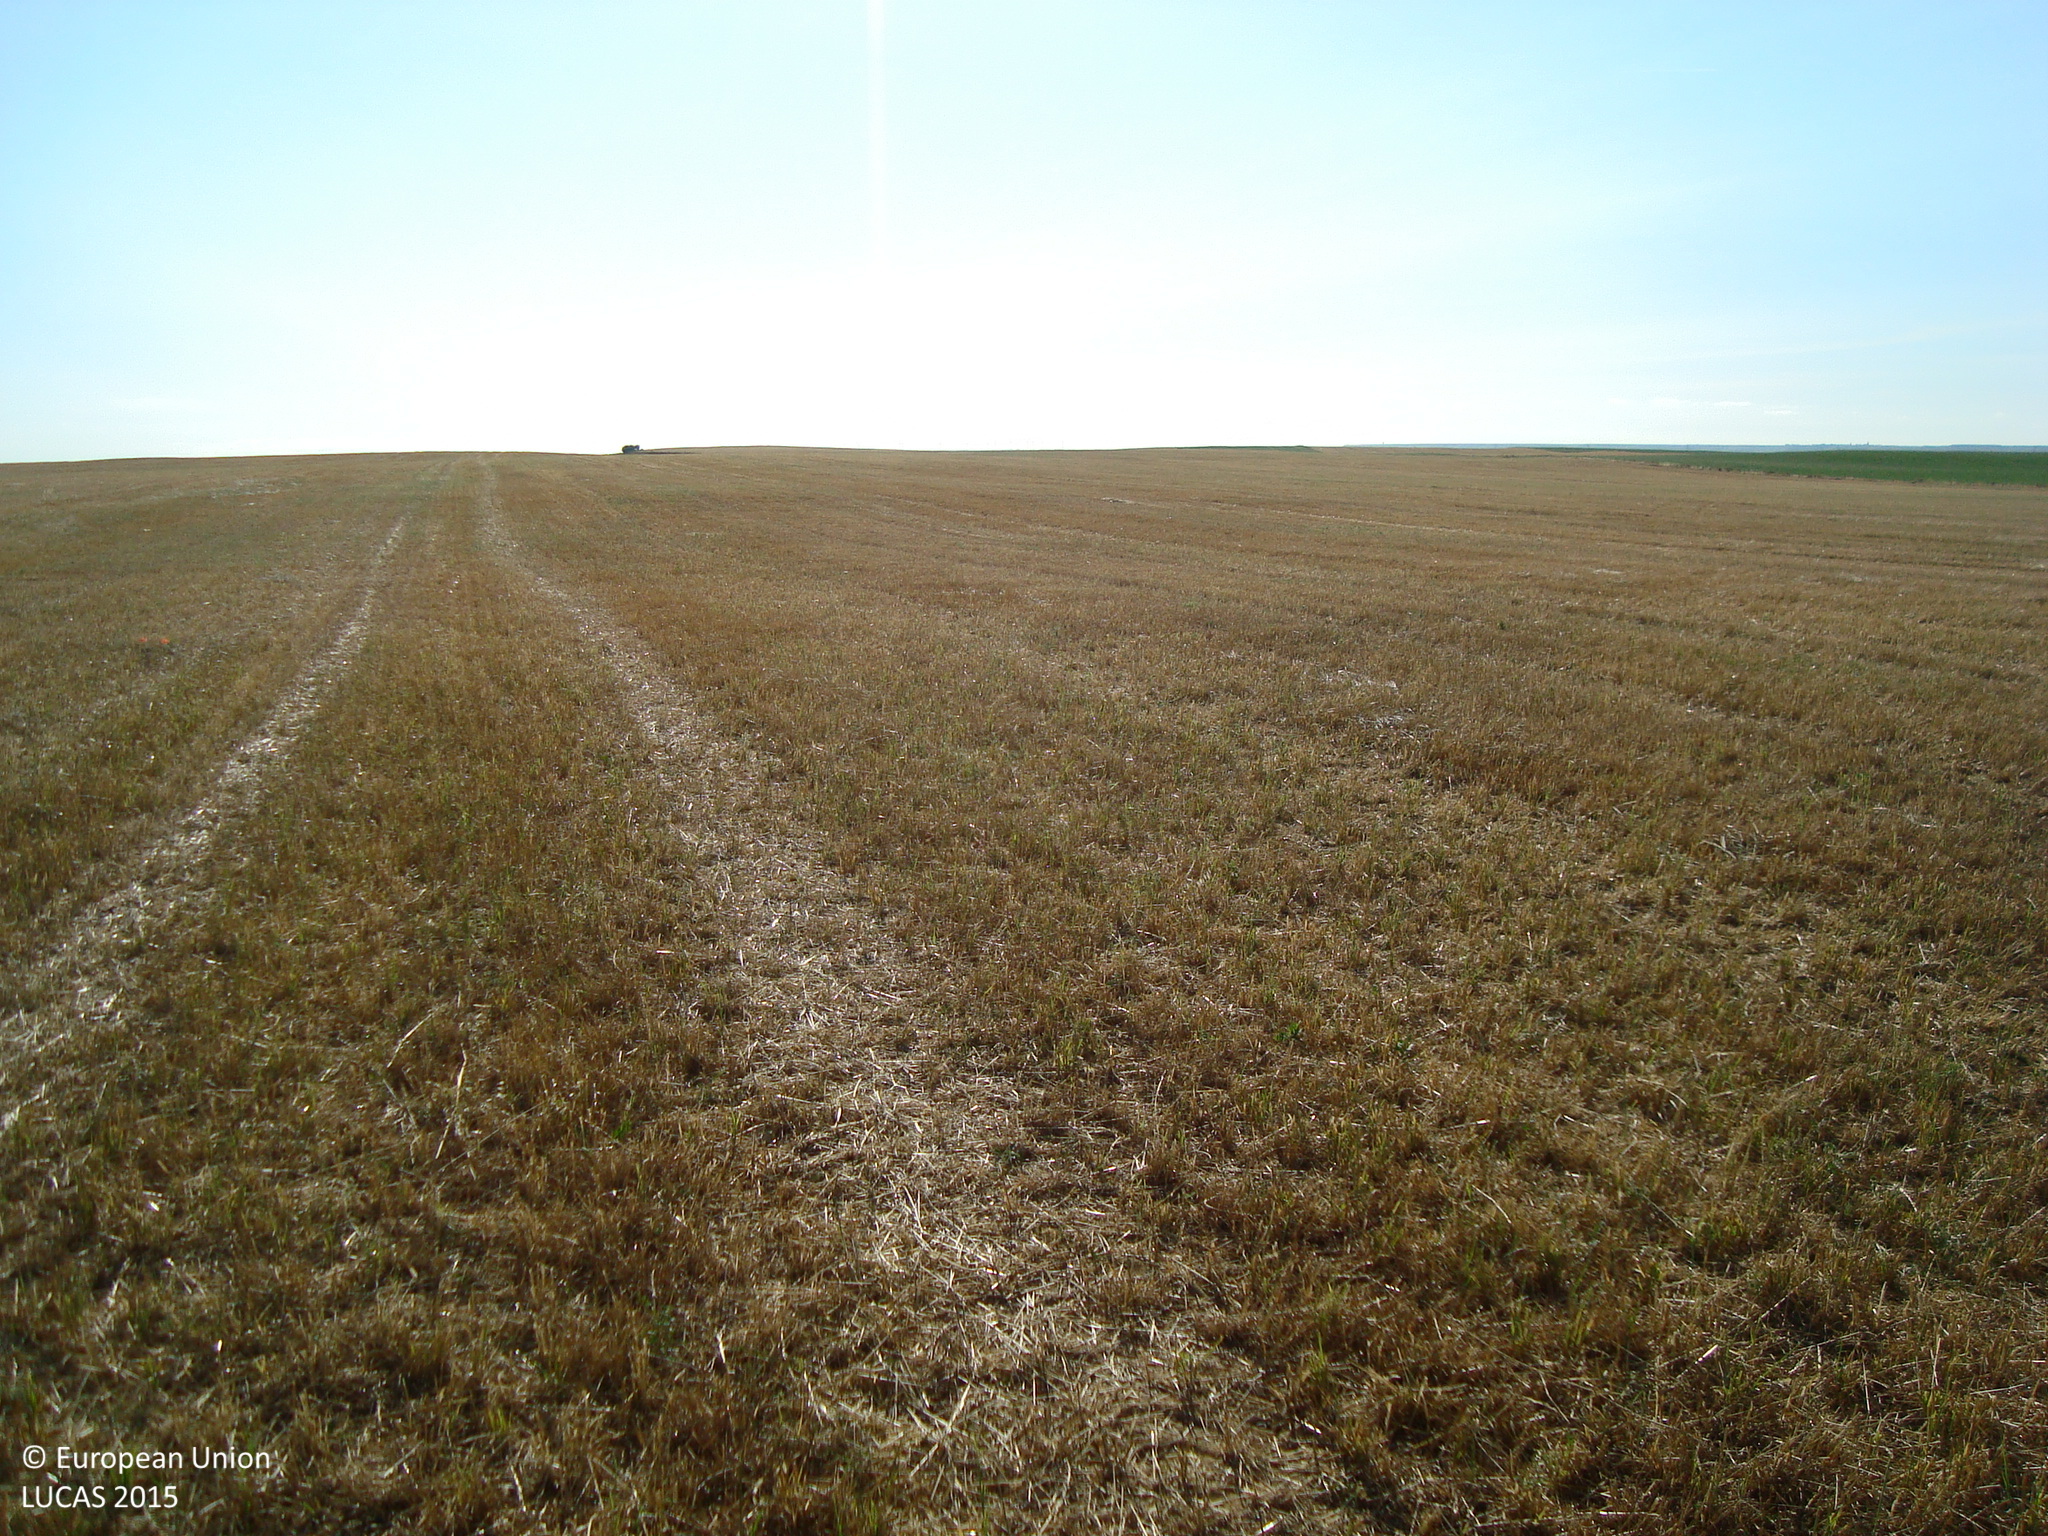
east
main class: Cropland
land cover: Barley
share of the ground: < 10 %
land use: Agriculture (excluding fallow land and kitchen gardens)
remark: Harvested field
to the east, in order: Barley
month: July
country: ES
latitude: 42.0364
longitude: -4.8004
